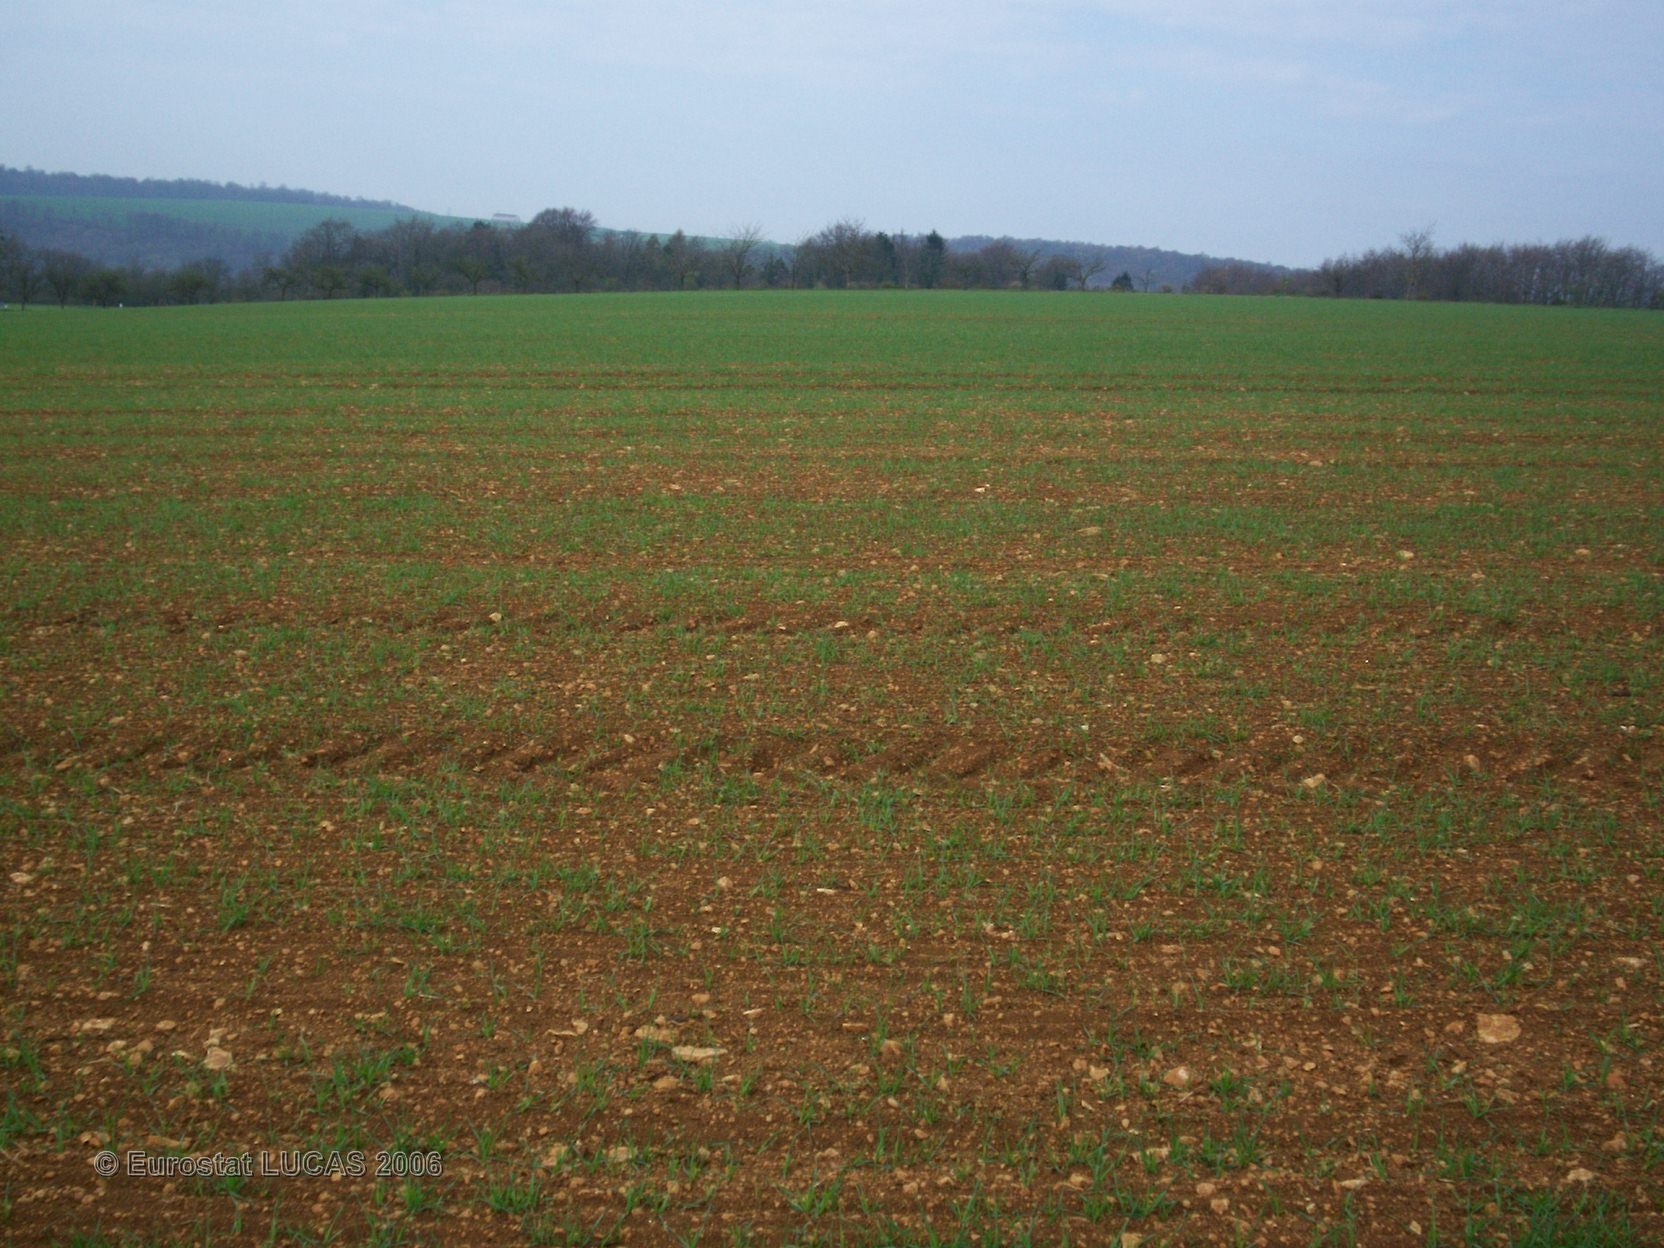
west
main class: Cropland
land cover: Barley
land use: Agriculture (excluding fallow land and kitchen gardens)
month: April
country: FR
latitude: 48.8518
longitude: 5.9520
